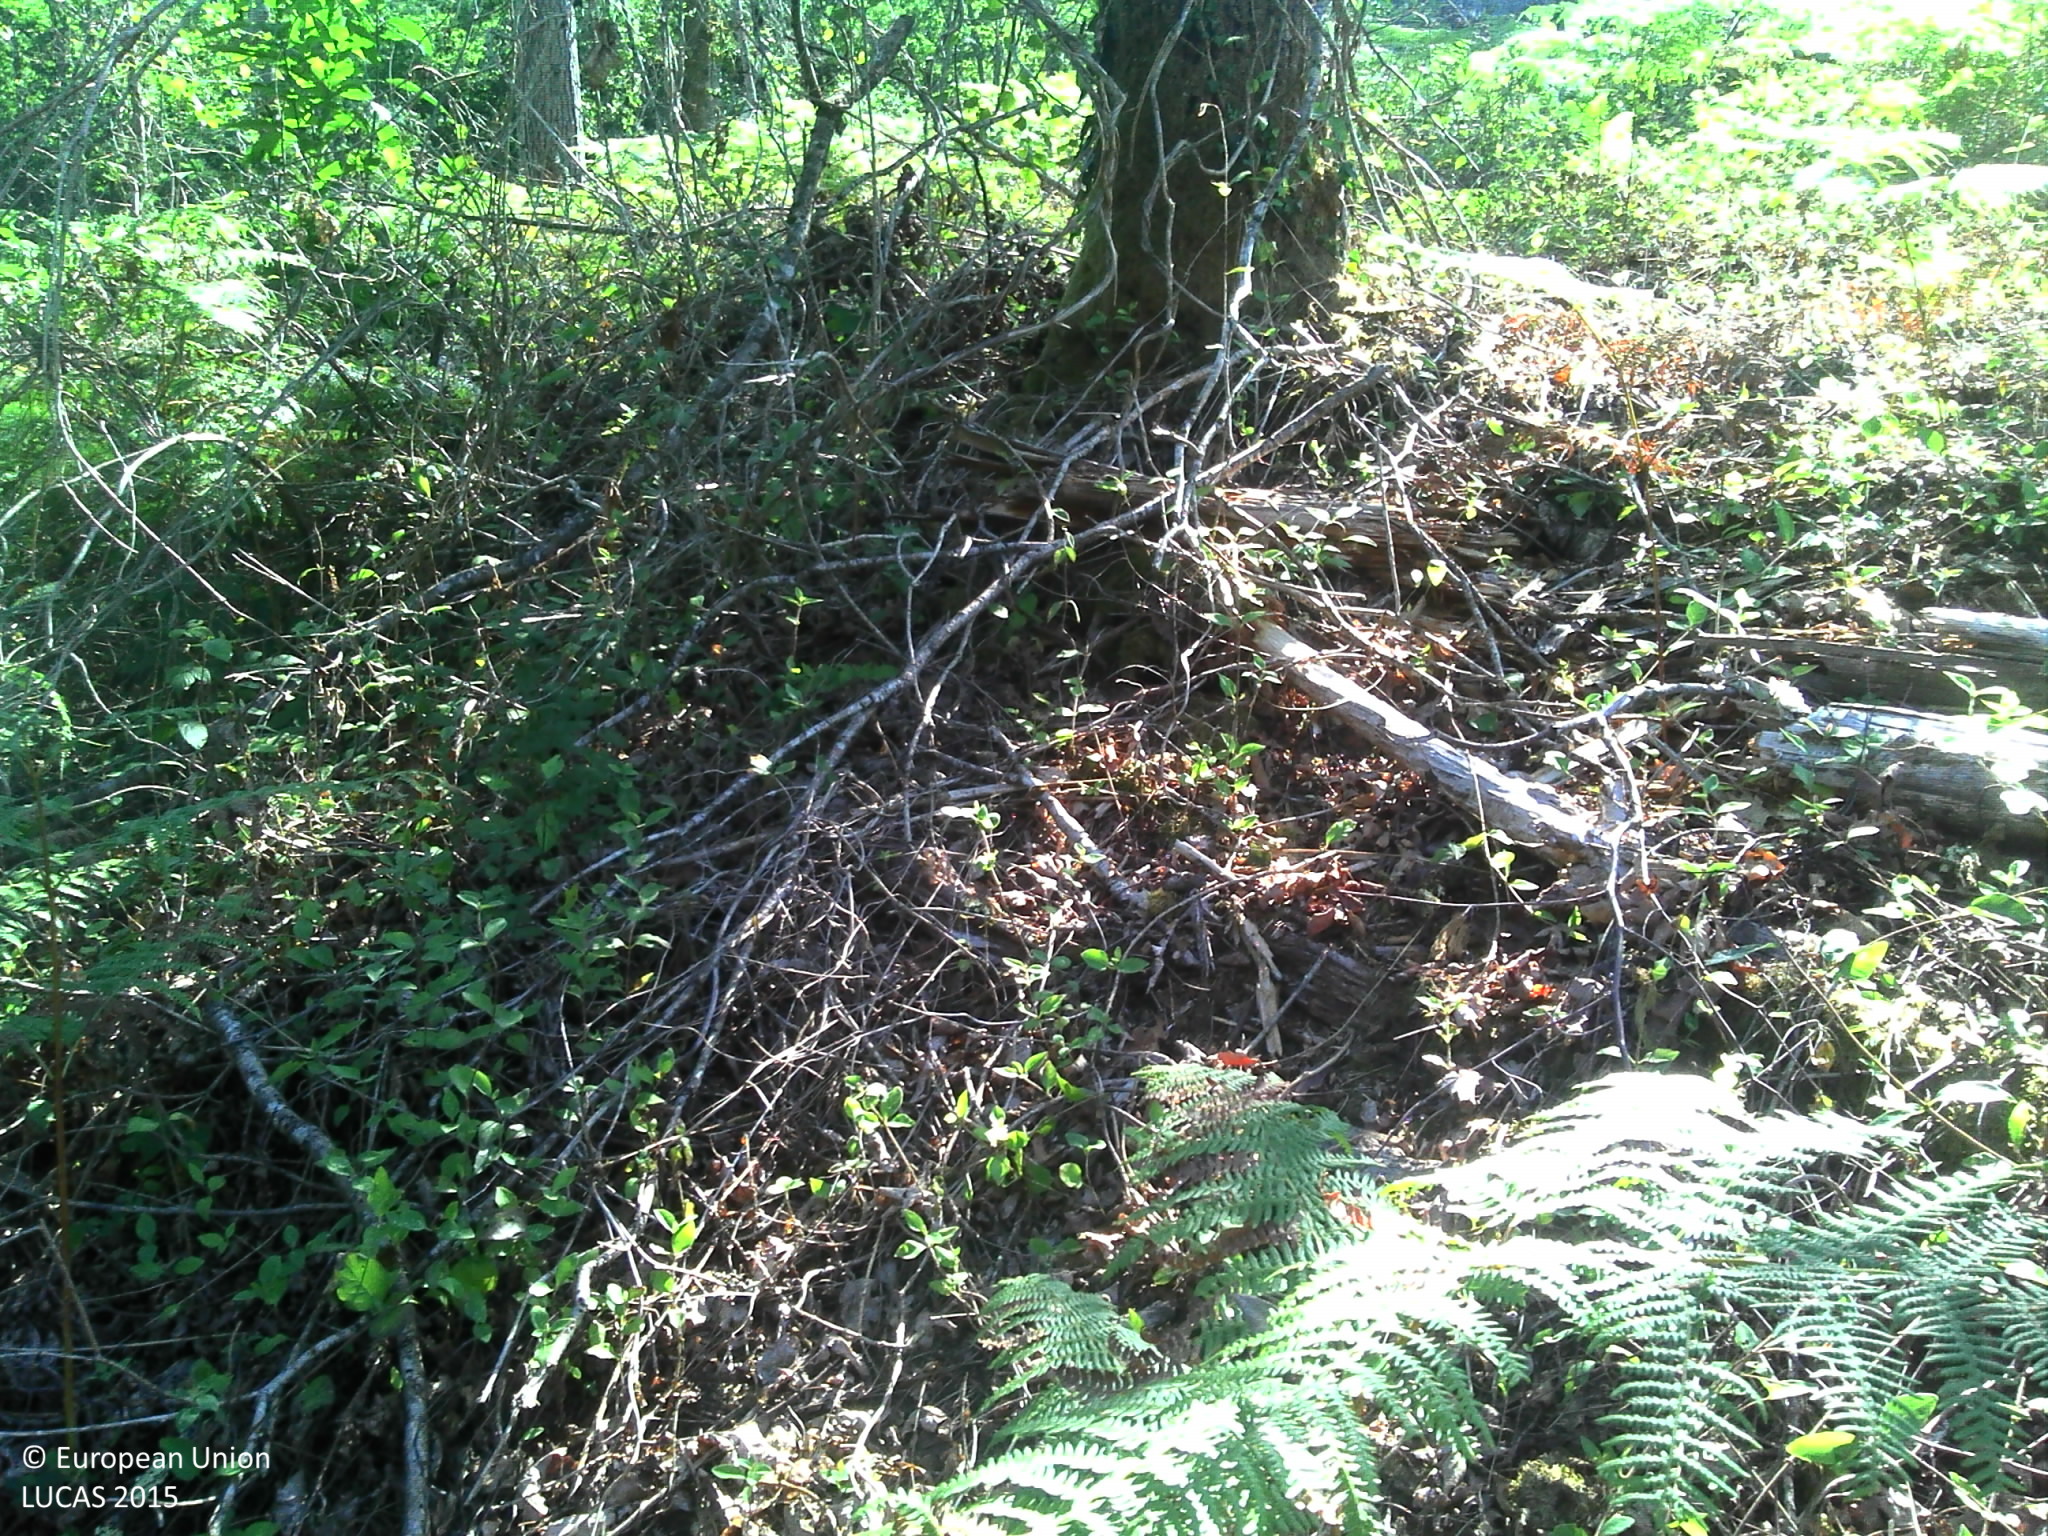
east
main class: Grassland
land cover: Spontaneously vegetated surfaces
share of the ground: > 75 %
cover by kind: herbaceous plants 95 %, shrubs 5 %
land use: Forestry
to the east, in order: Spontaneously vegetated surfaces; Tracks; Rivers and streams; Pine dominated mixed woodland
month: August
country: FR
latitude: 45.8795
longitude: 1.4234
